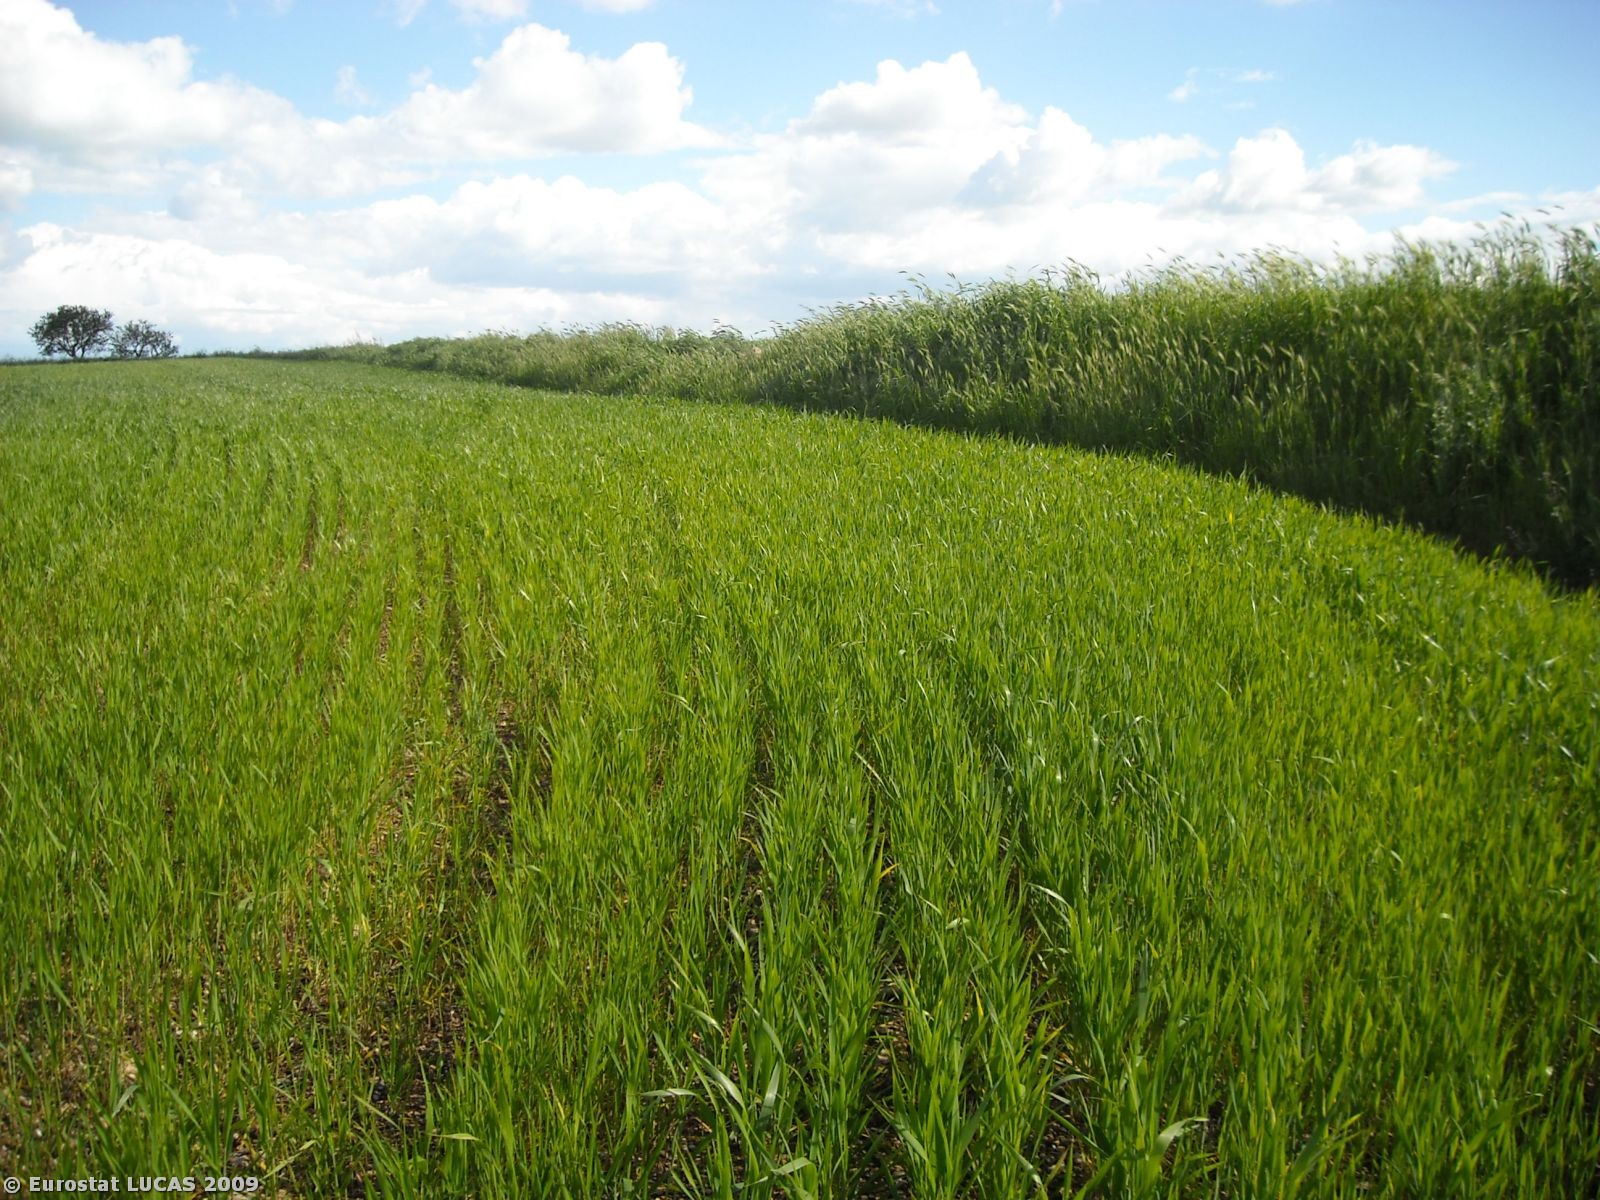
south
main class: Cropland
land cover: Durum wheat
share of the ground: > 75 %
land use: Agriculture (excluding fallow land and kitchen gardens)
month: April
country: IT
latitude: 40.7708
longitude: 16.6003
